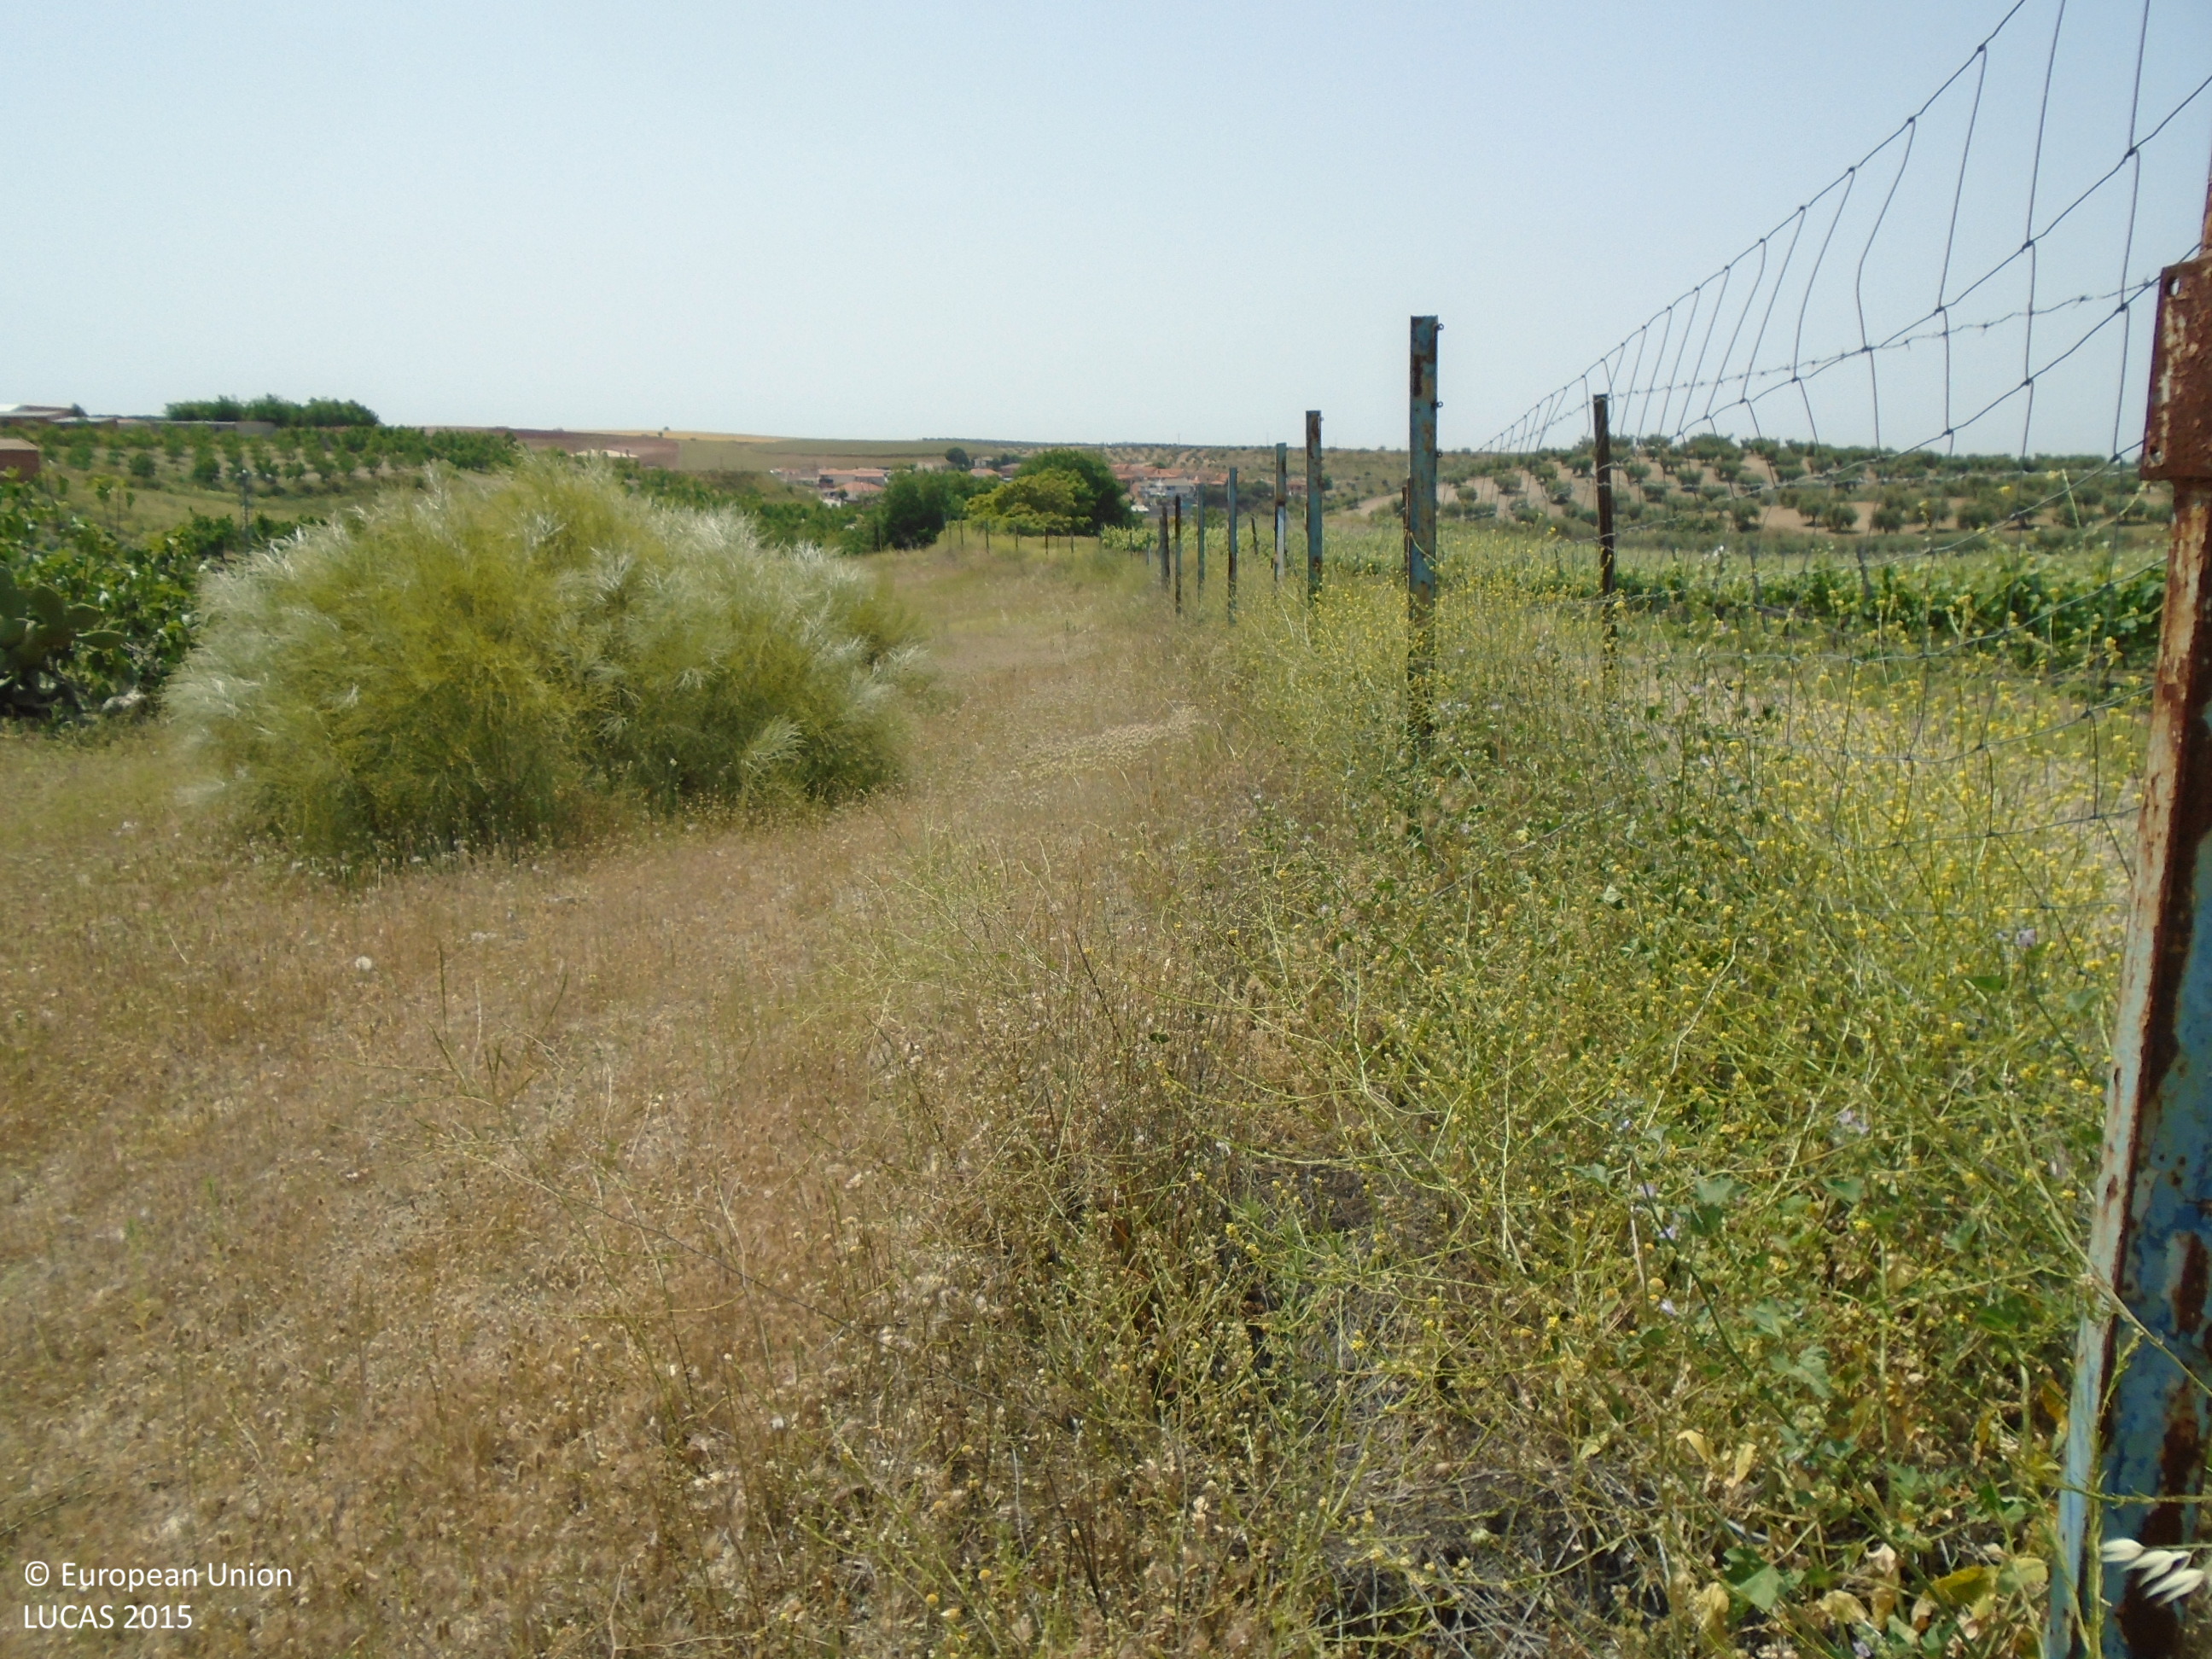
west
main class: Cropland
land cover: Vineyards
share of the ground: 10 - 25 %
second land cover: Other bare soil
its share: > 75 %
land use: Agriculture (excluding fallow land and kitchen gardens)
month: May
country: ES
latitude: 39.7885
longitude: -4.6270
